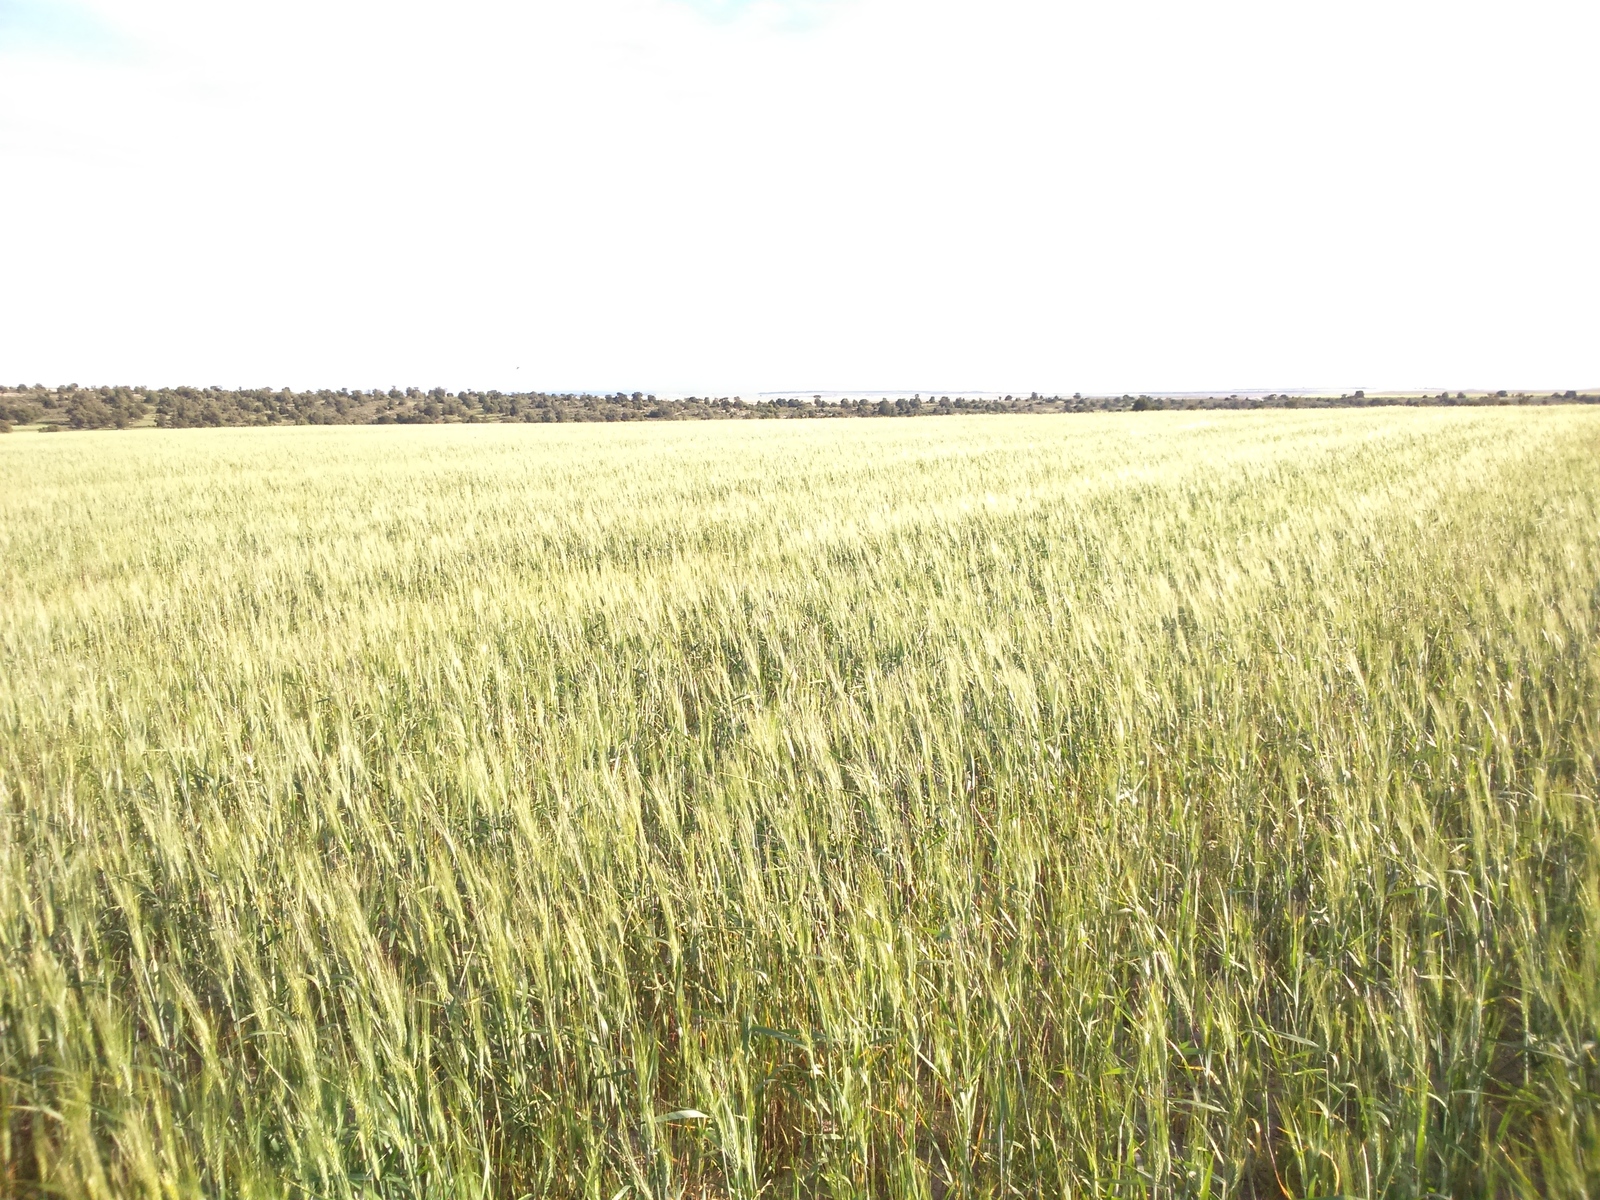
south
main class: Cropland
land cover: Durum wheat
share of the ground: > 75 %
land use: Agriculture (excluding fallow land and kitchen gardens)
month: April
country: ES
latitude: 41.4389
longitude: -0.2724
